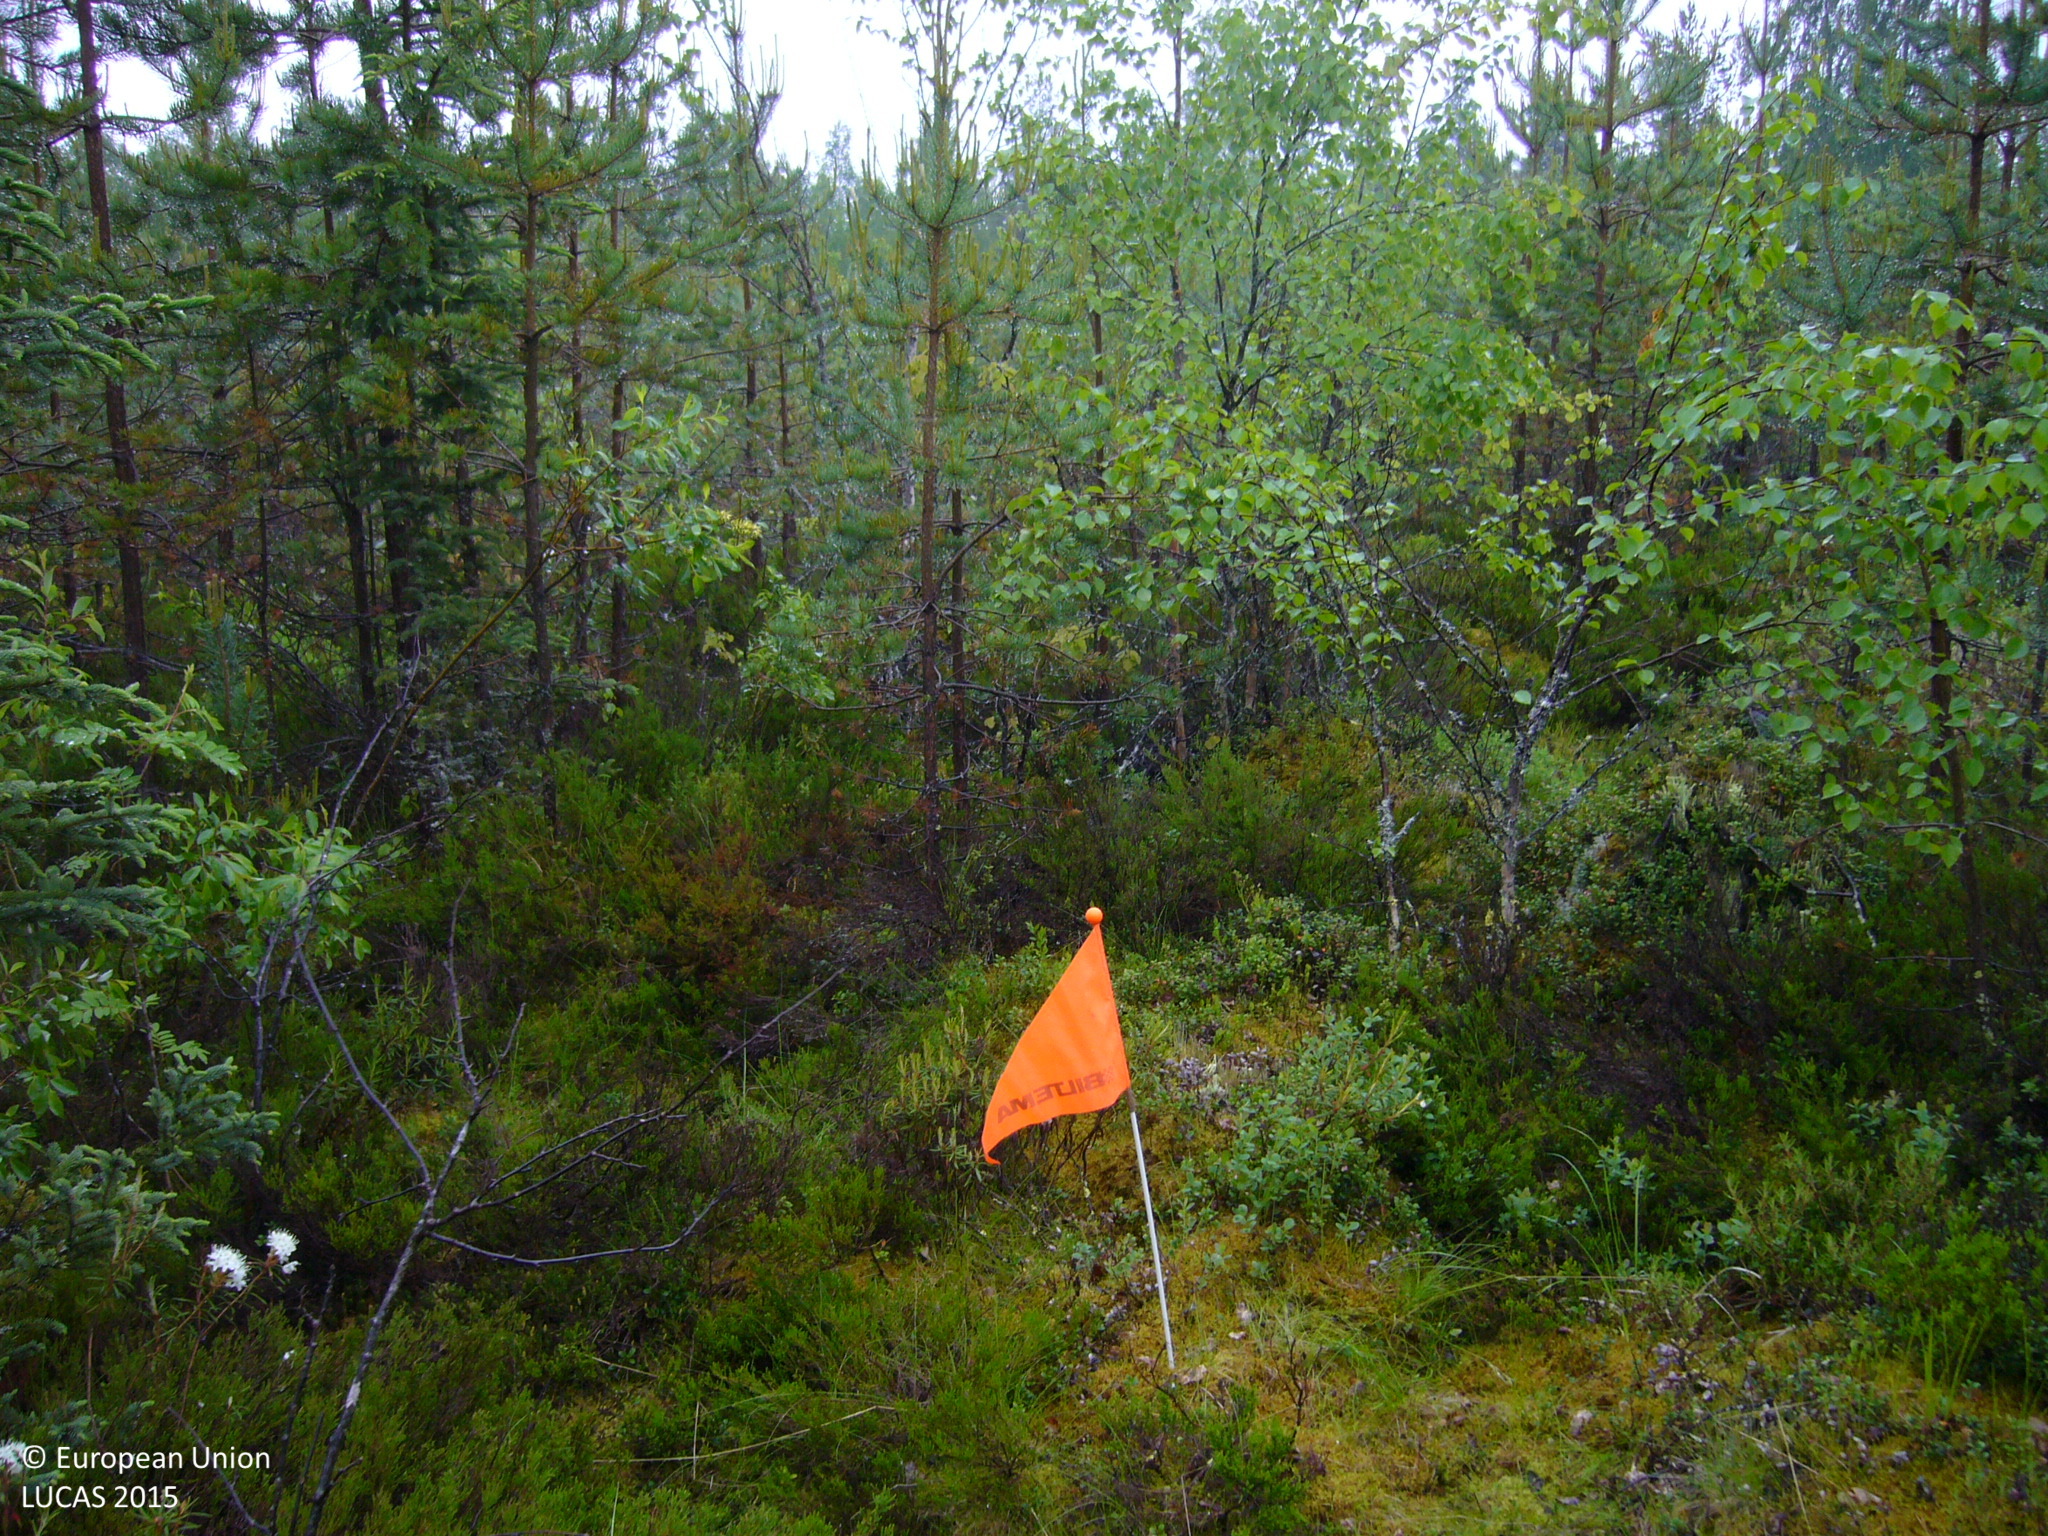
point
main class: Woodland
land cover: Pine dominated mixed woodland
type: boreal forest
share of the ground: 50 - 75 %
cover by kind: shrubs 45 %, coniferous forest trees 30 %, broadleaved forest trees 25 %
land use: Forestry
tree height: < 5 m
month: June
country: FI
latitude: 63.8112
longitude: 24.9728
